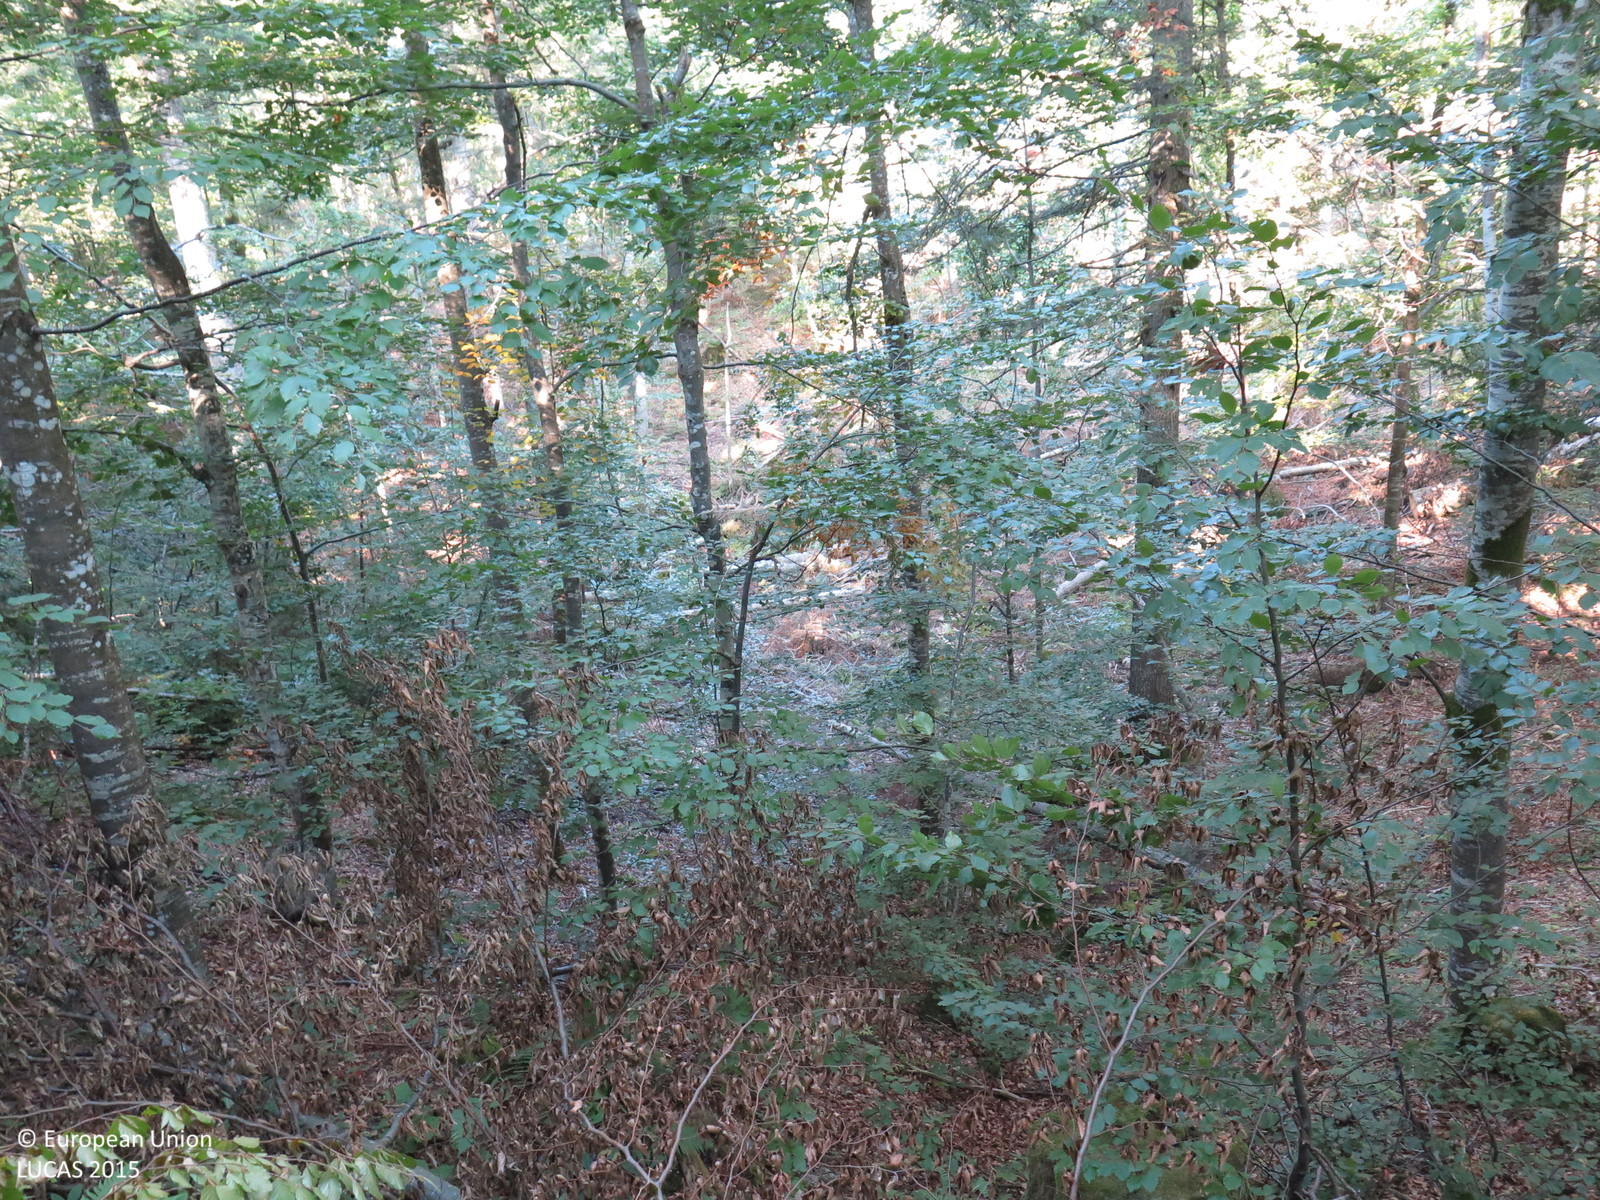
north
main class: Woodland
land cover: Other mixed woodland
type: mountainous beech forest
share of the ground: > 75 %
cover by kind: broadleaved forest trees 75 %, coniferous forest trees 25 %
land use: Forestry
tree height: > 5 m
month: September
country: HR
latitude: 45.5488
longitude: 14.5938
